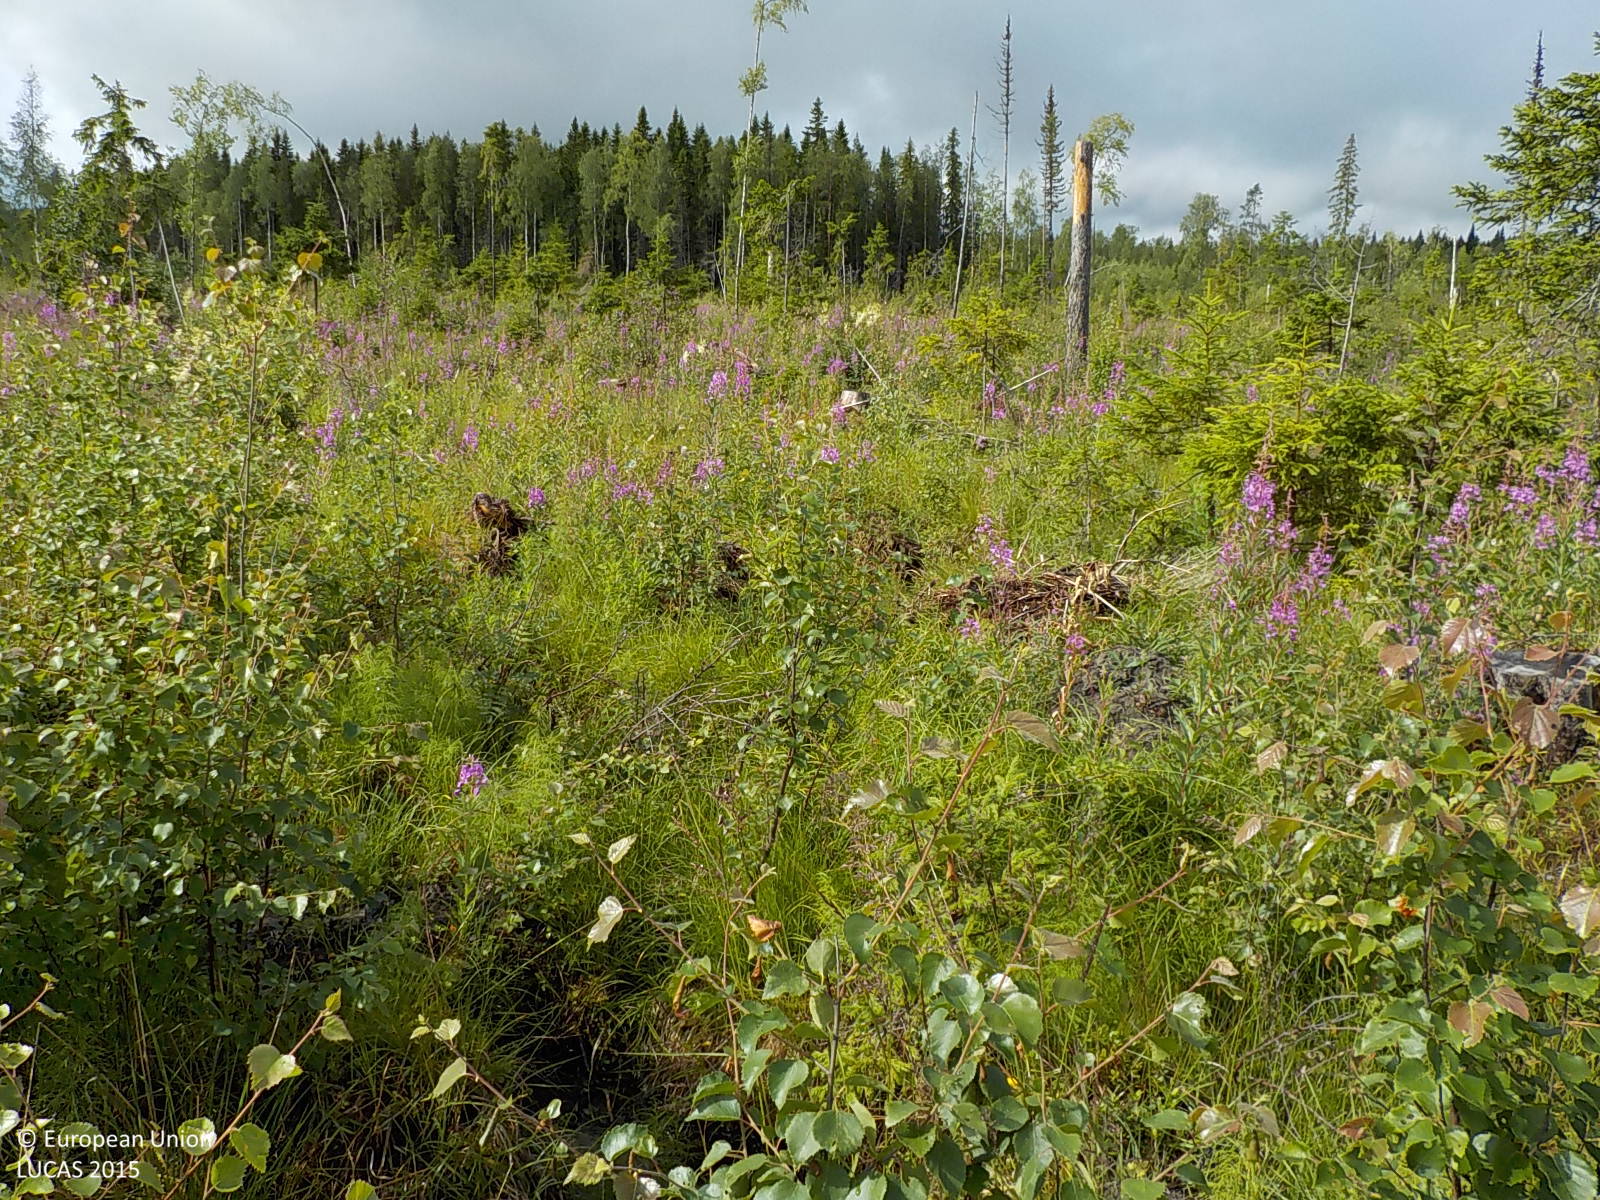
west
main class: Woodland
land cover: Broadleaved woodland
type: boreal forest
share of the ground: 50 - 75 %
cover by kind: shrubs 50 %, broadleaved forest trees 40 %, coniferous forest trees 10 %
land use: Forestry
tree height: < 5 m
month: July
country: SE
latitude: 63.2141
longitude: 16.9168
